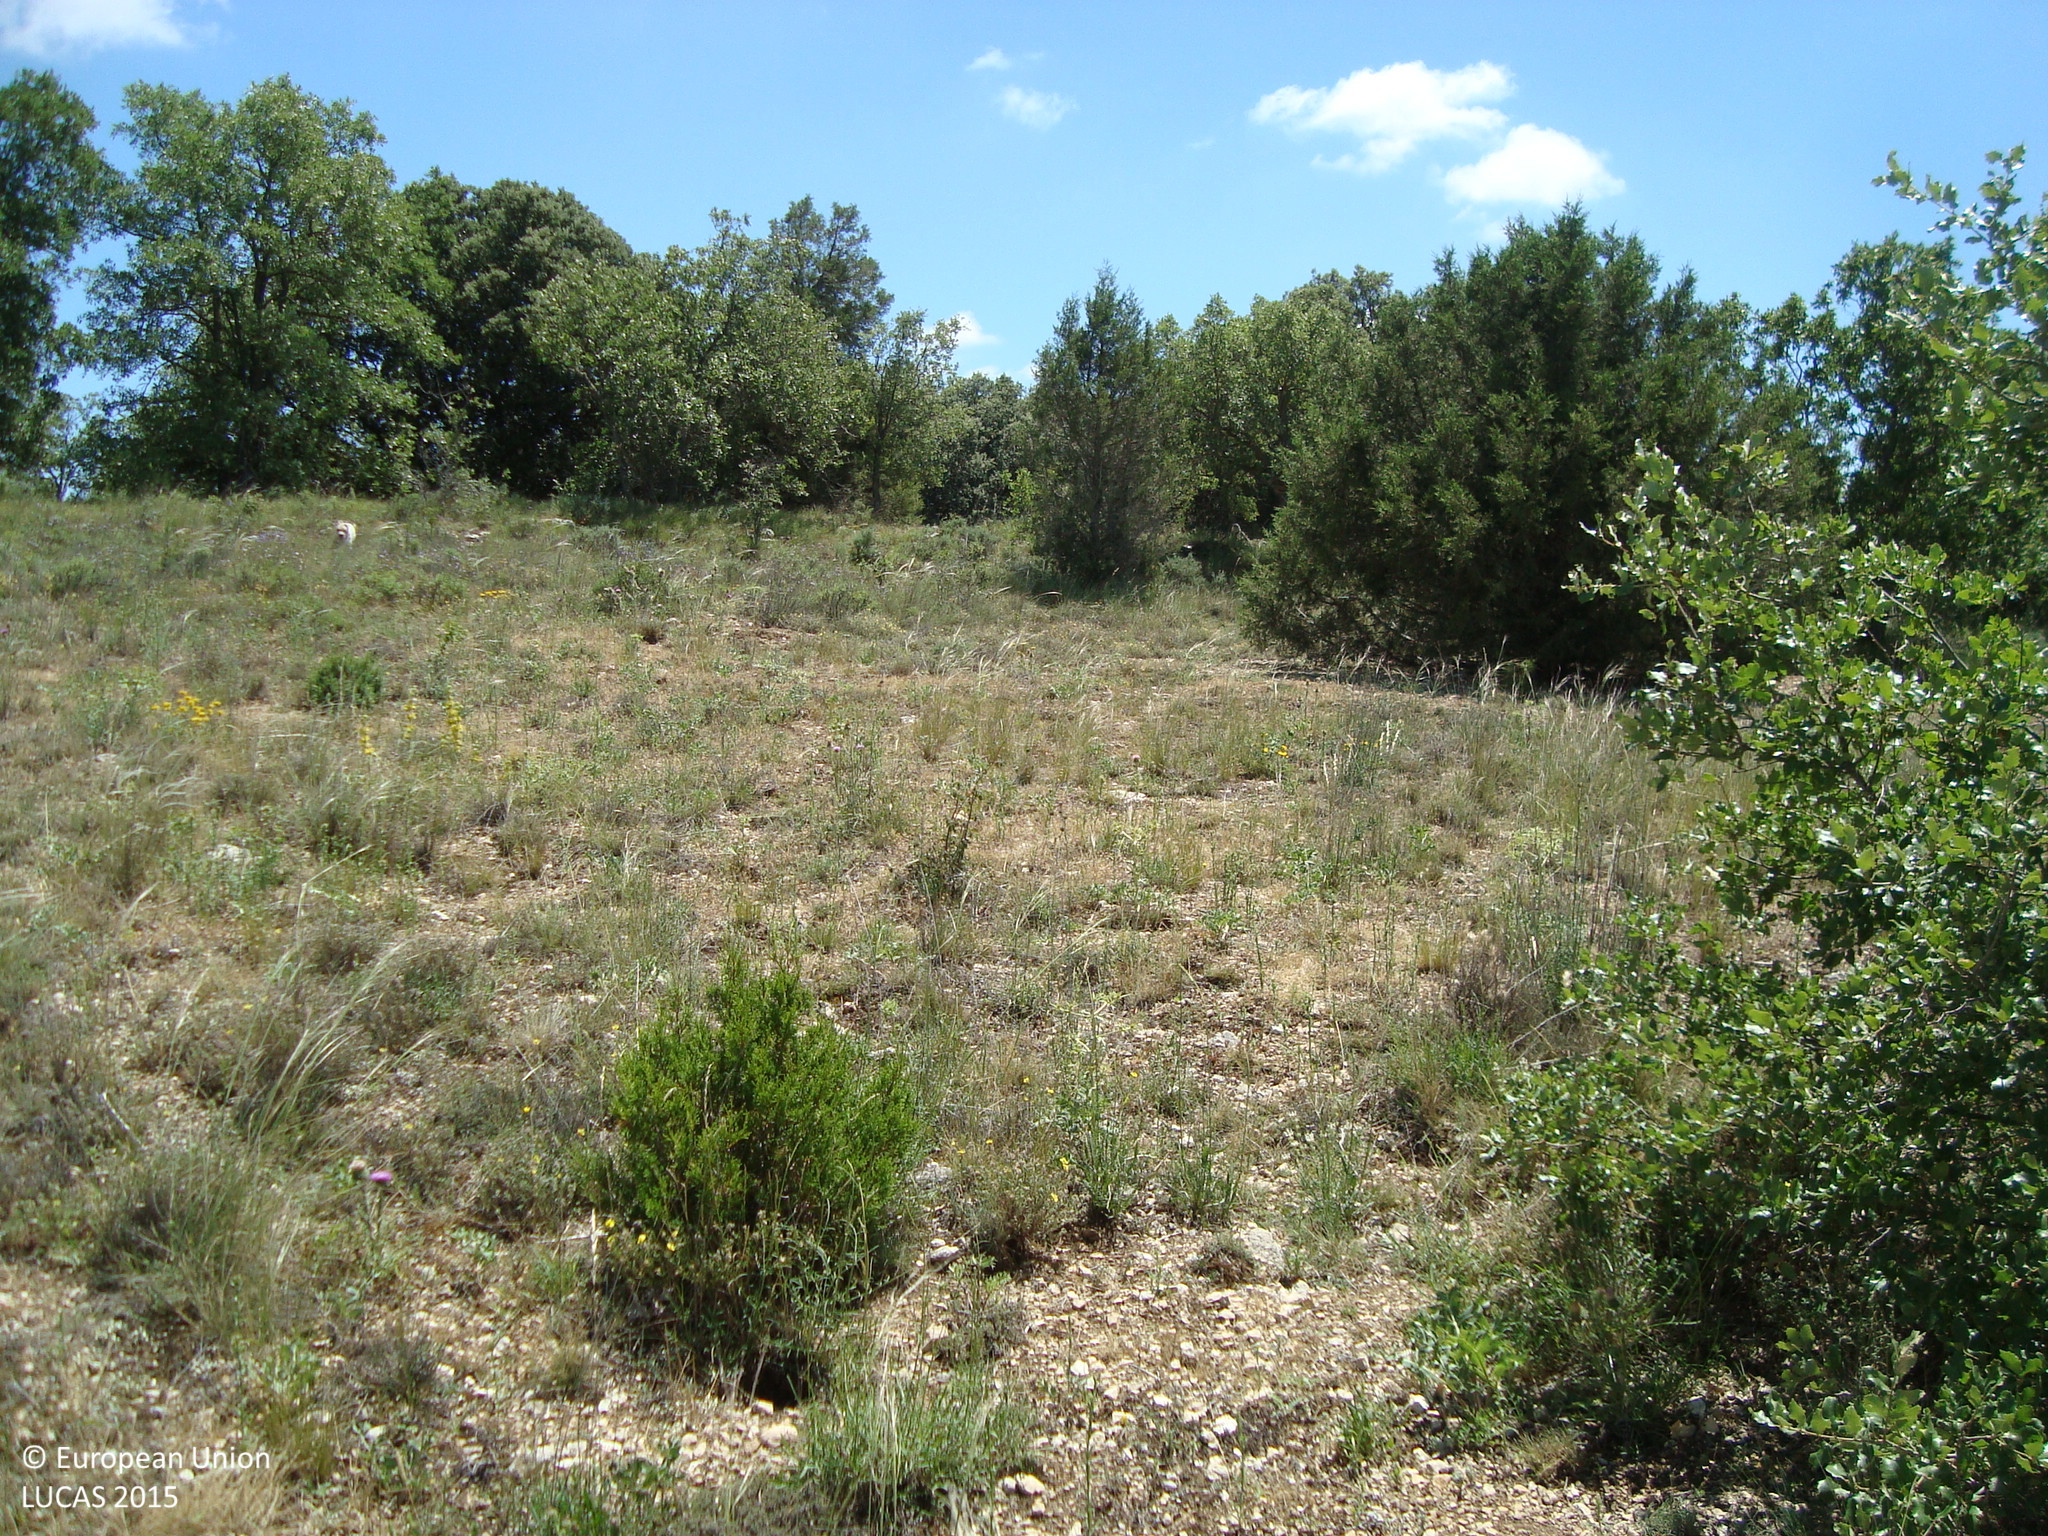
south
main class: Grassland
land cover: Grassland with sparse tree/shrub cover
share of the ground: > 75 %
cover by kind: herbaceous plants 65 %, unconsolidated bare surface 25 %, broadleaved forest trees 5 %, shrubs 5 %
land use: Forestry
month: June
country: ES
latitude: 41.6986
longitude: -4.2285
